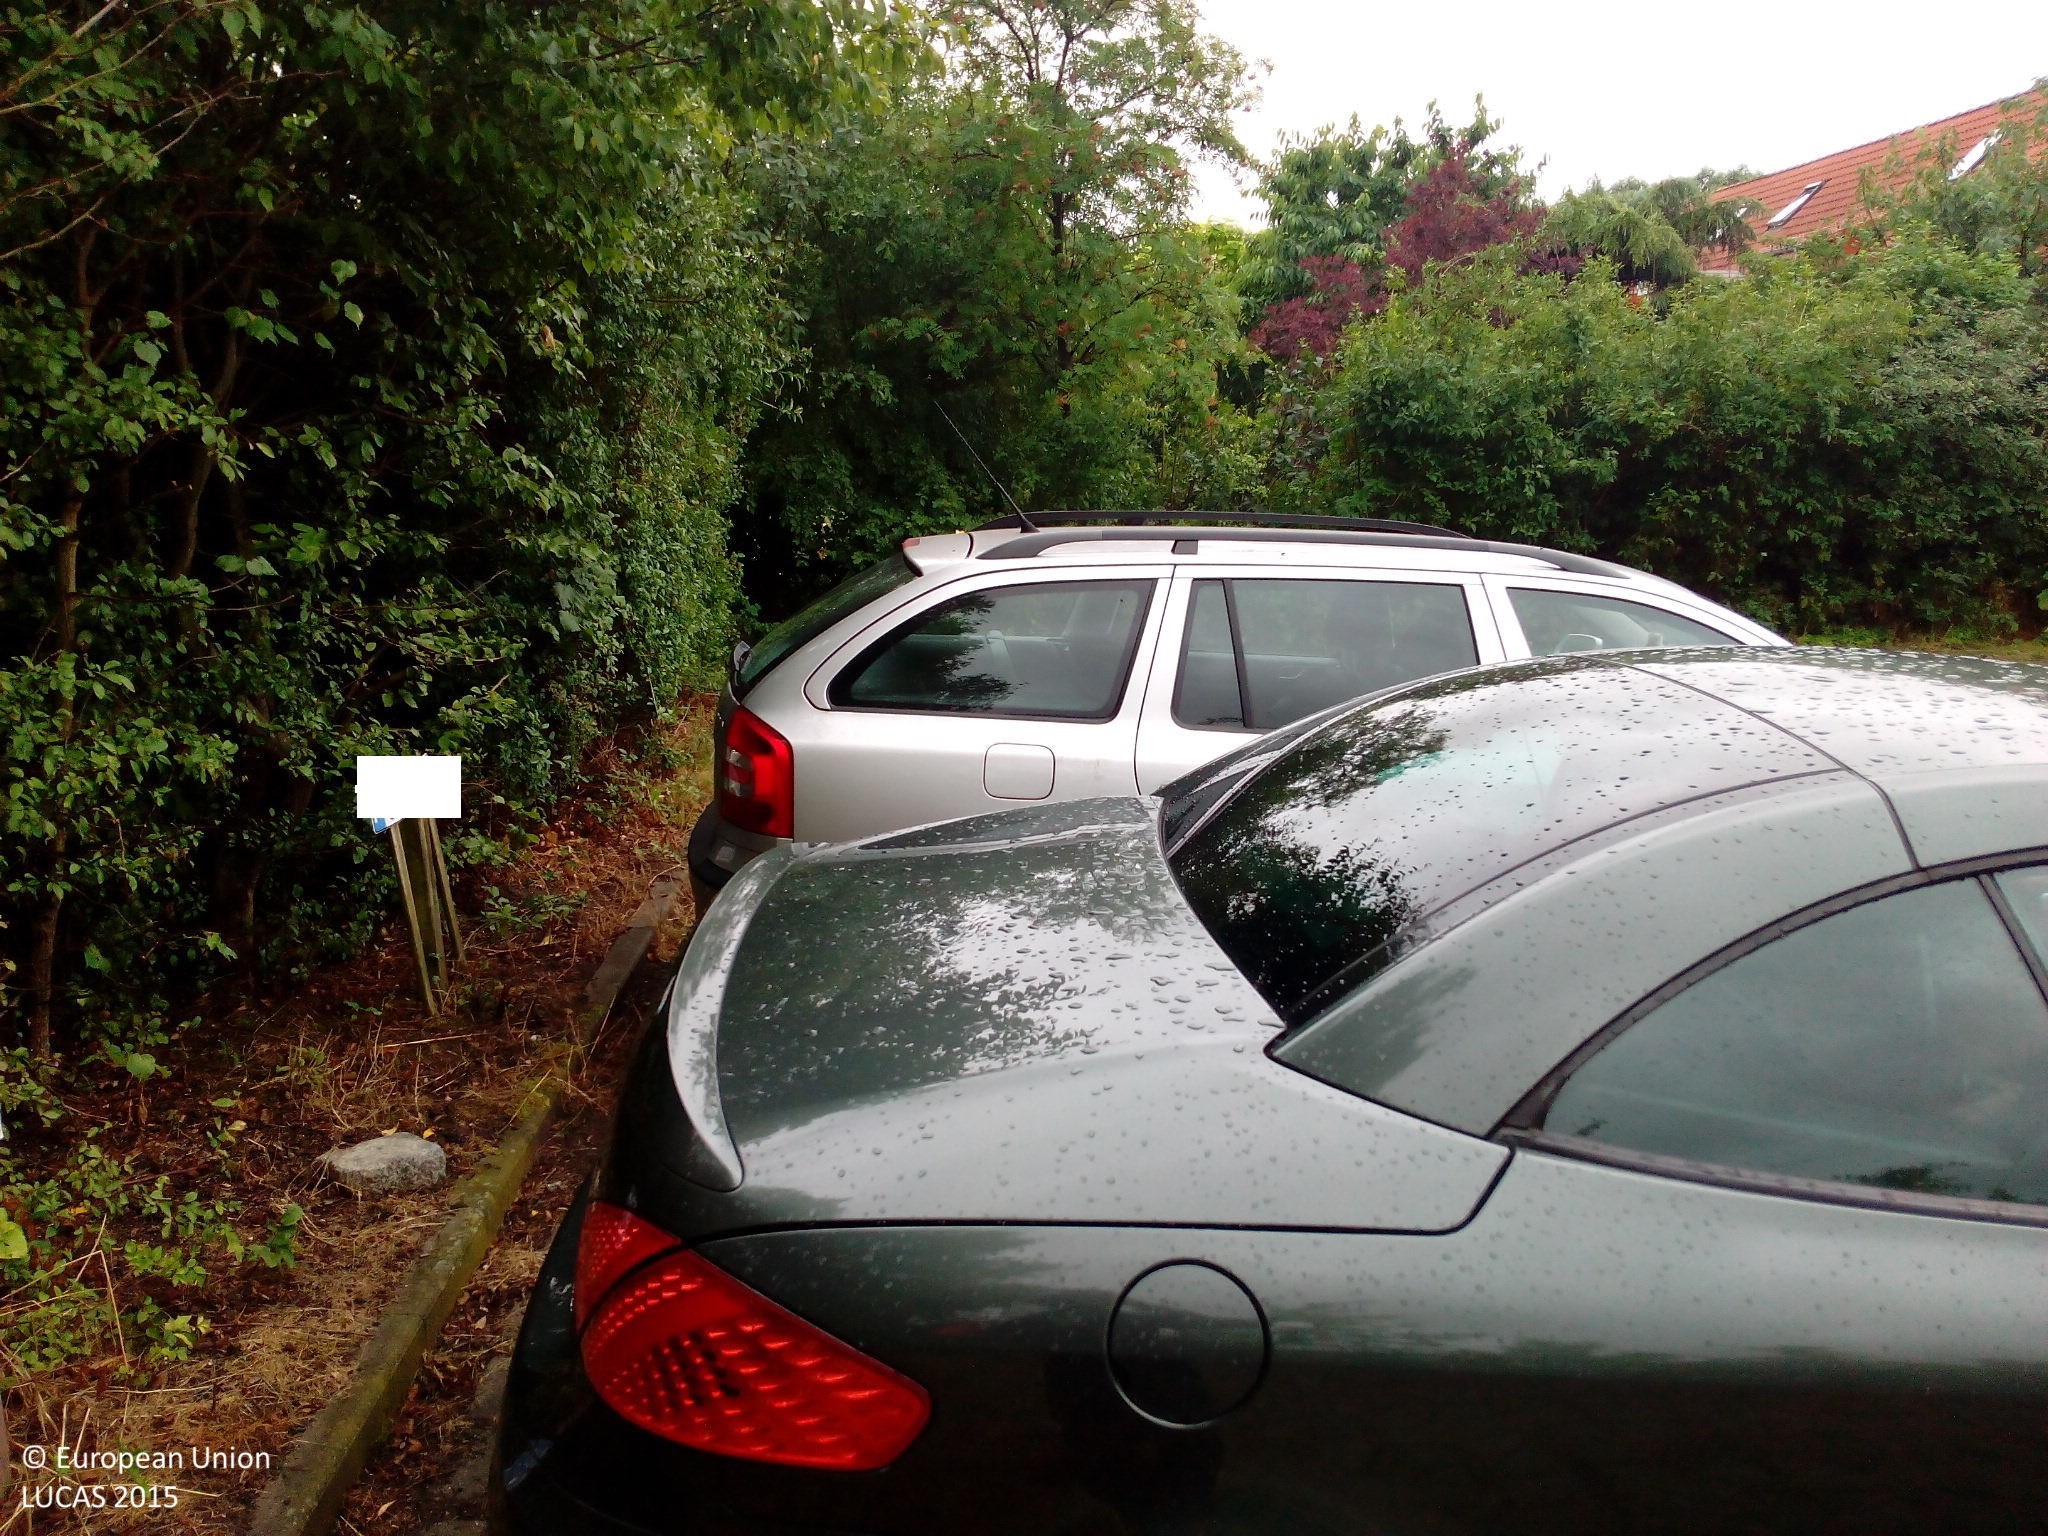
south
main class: Shrubland
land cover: Shrubland with sparse tree cover
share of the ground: > 75 %
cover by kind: shrubs 95 %, broadleaved forest trees 5 %
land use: Residential
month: July
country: DE
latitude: 52.6962
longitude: 13.1220
